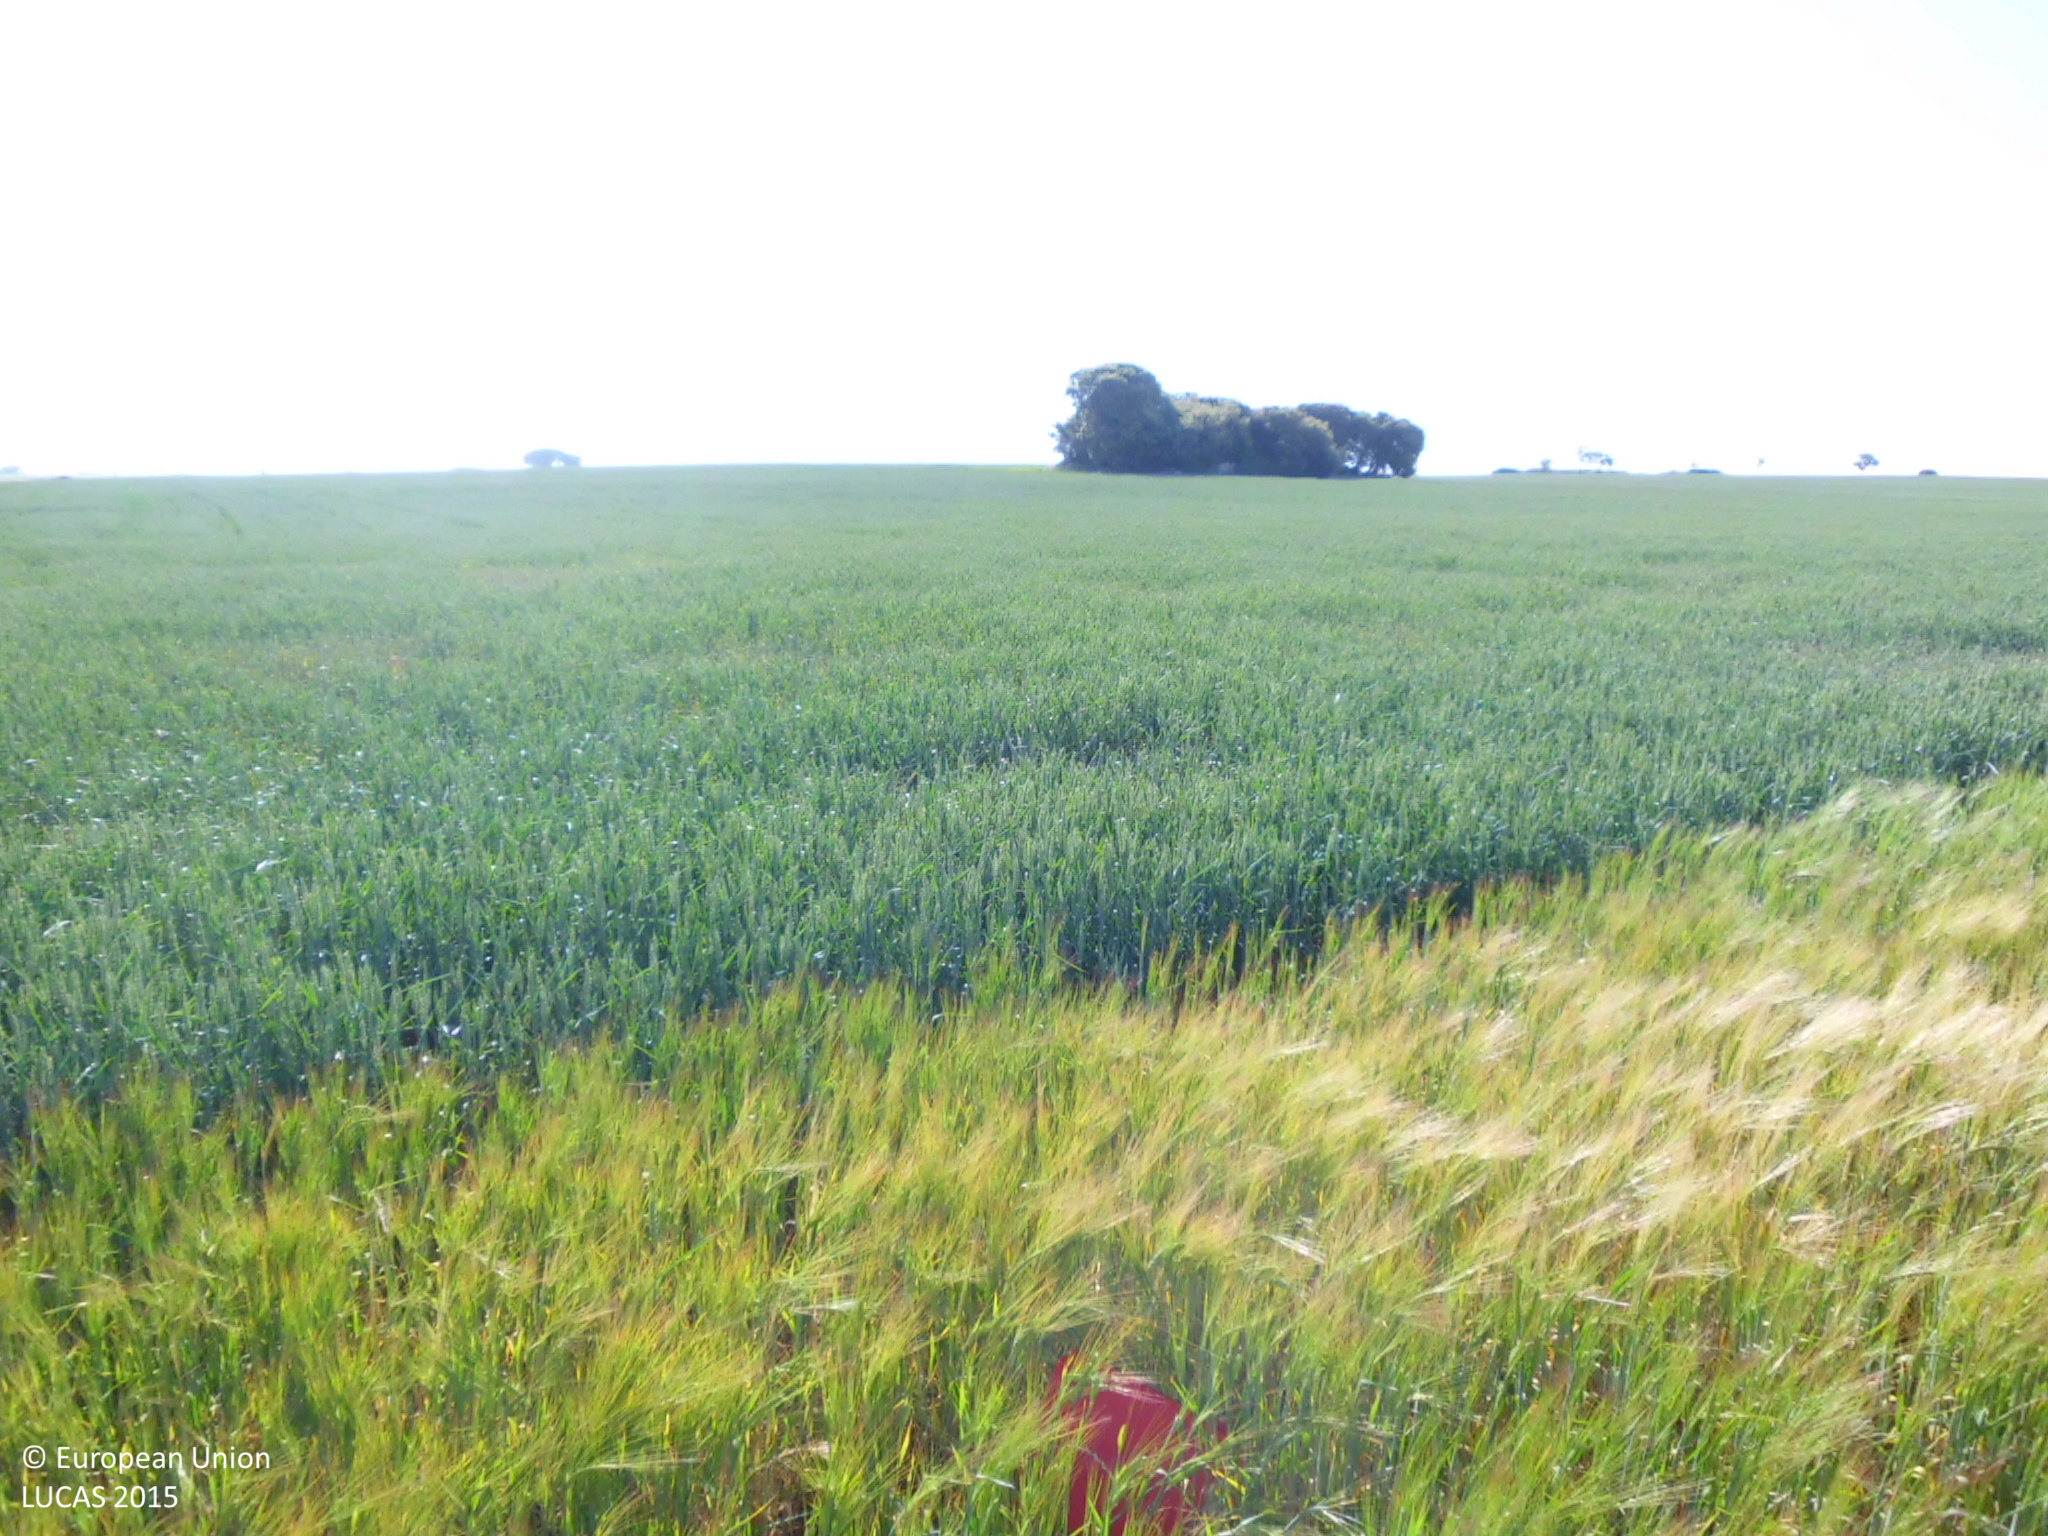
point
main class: Cropland
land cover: Barley
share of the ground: > 75 %
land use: Agriculture (excluding fallow land and kitchen gardens)
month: June
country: ES
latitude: 42.3337
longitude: -4.0100
